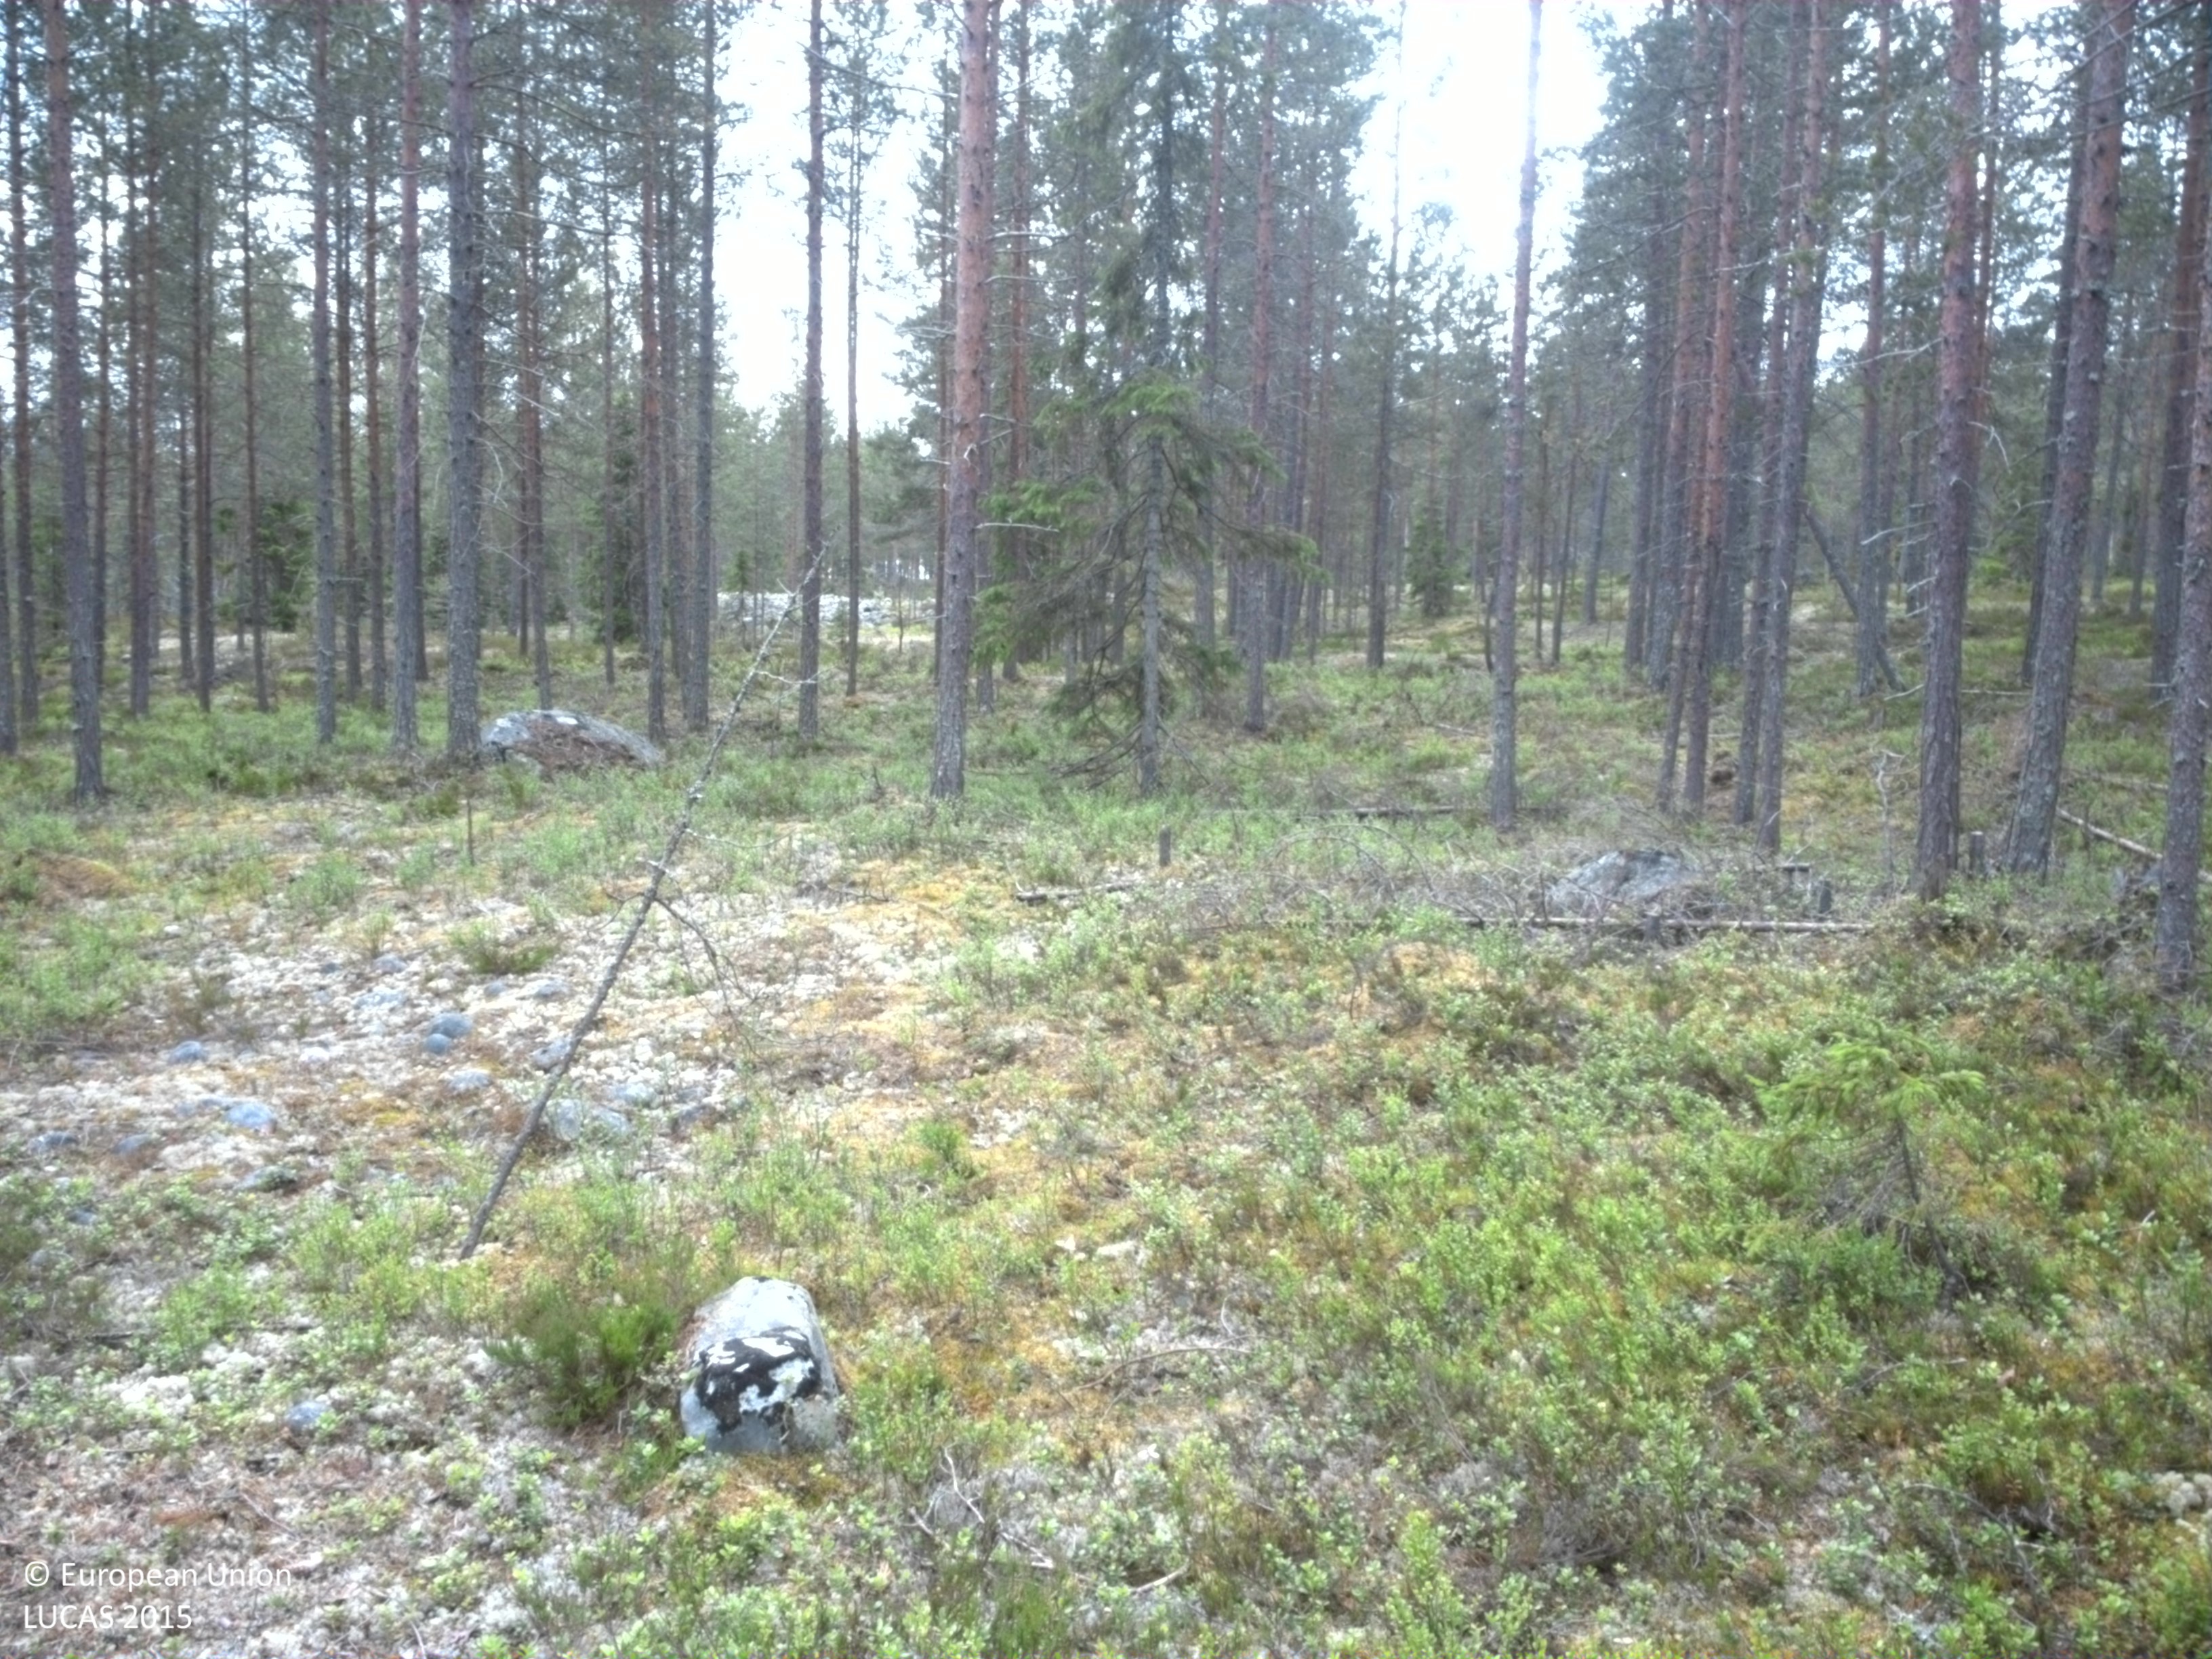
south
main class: Woodland
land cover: Pine dominated coniferous woodland
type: boreal forest
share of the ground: 50 - 75 %
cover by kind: coniferous forest trees 65 %, shrubs 30 %, lichens and mosses 5 %
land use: Forestry
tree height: > 5 m
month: July
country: SE
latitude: 64.5416
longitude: 21.3047
